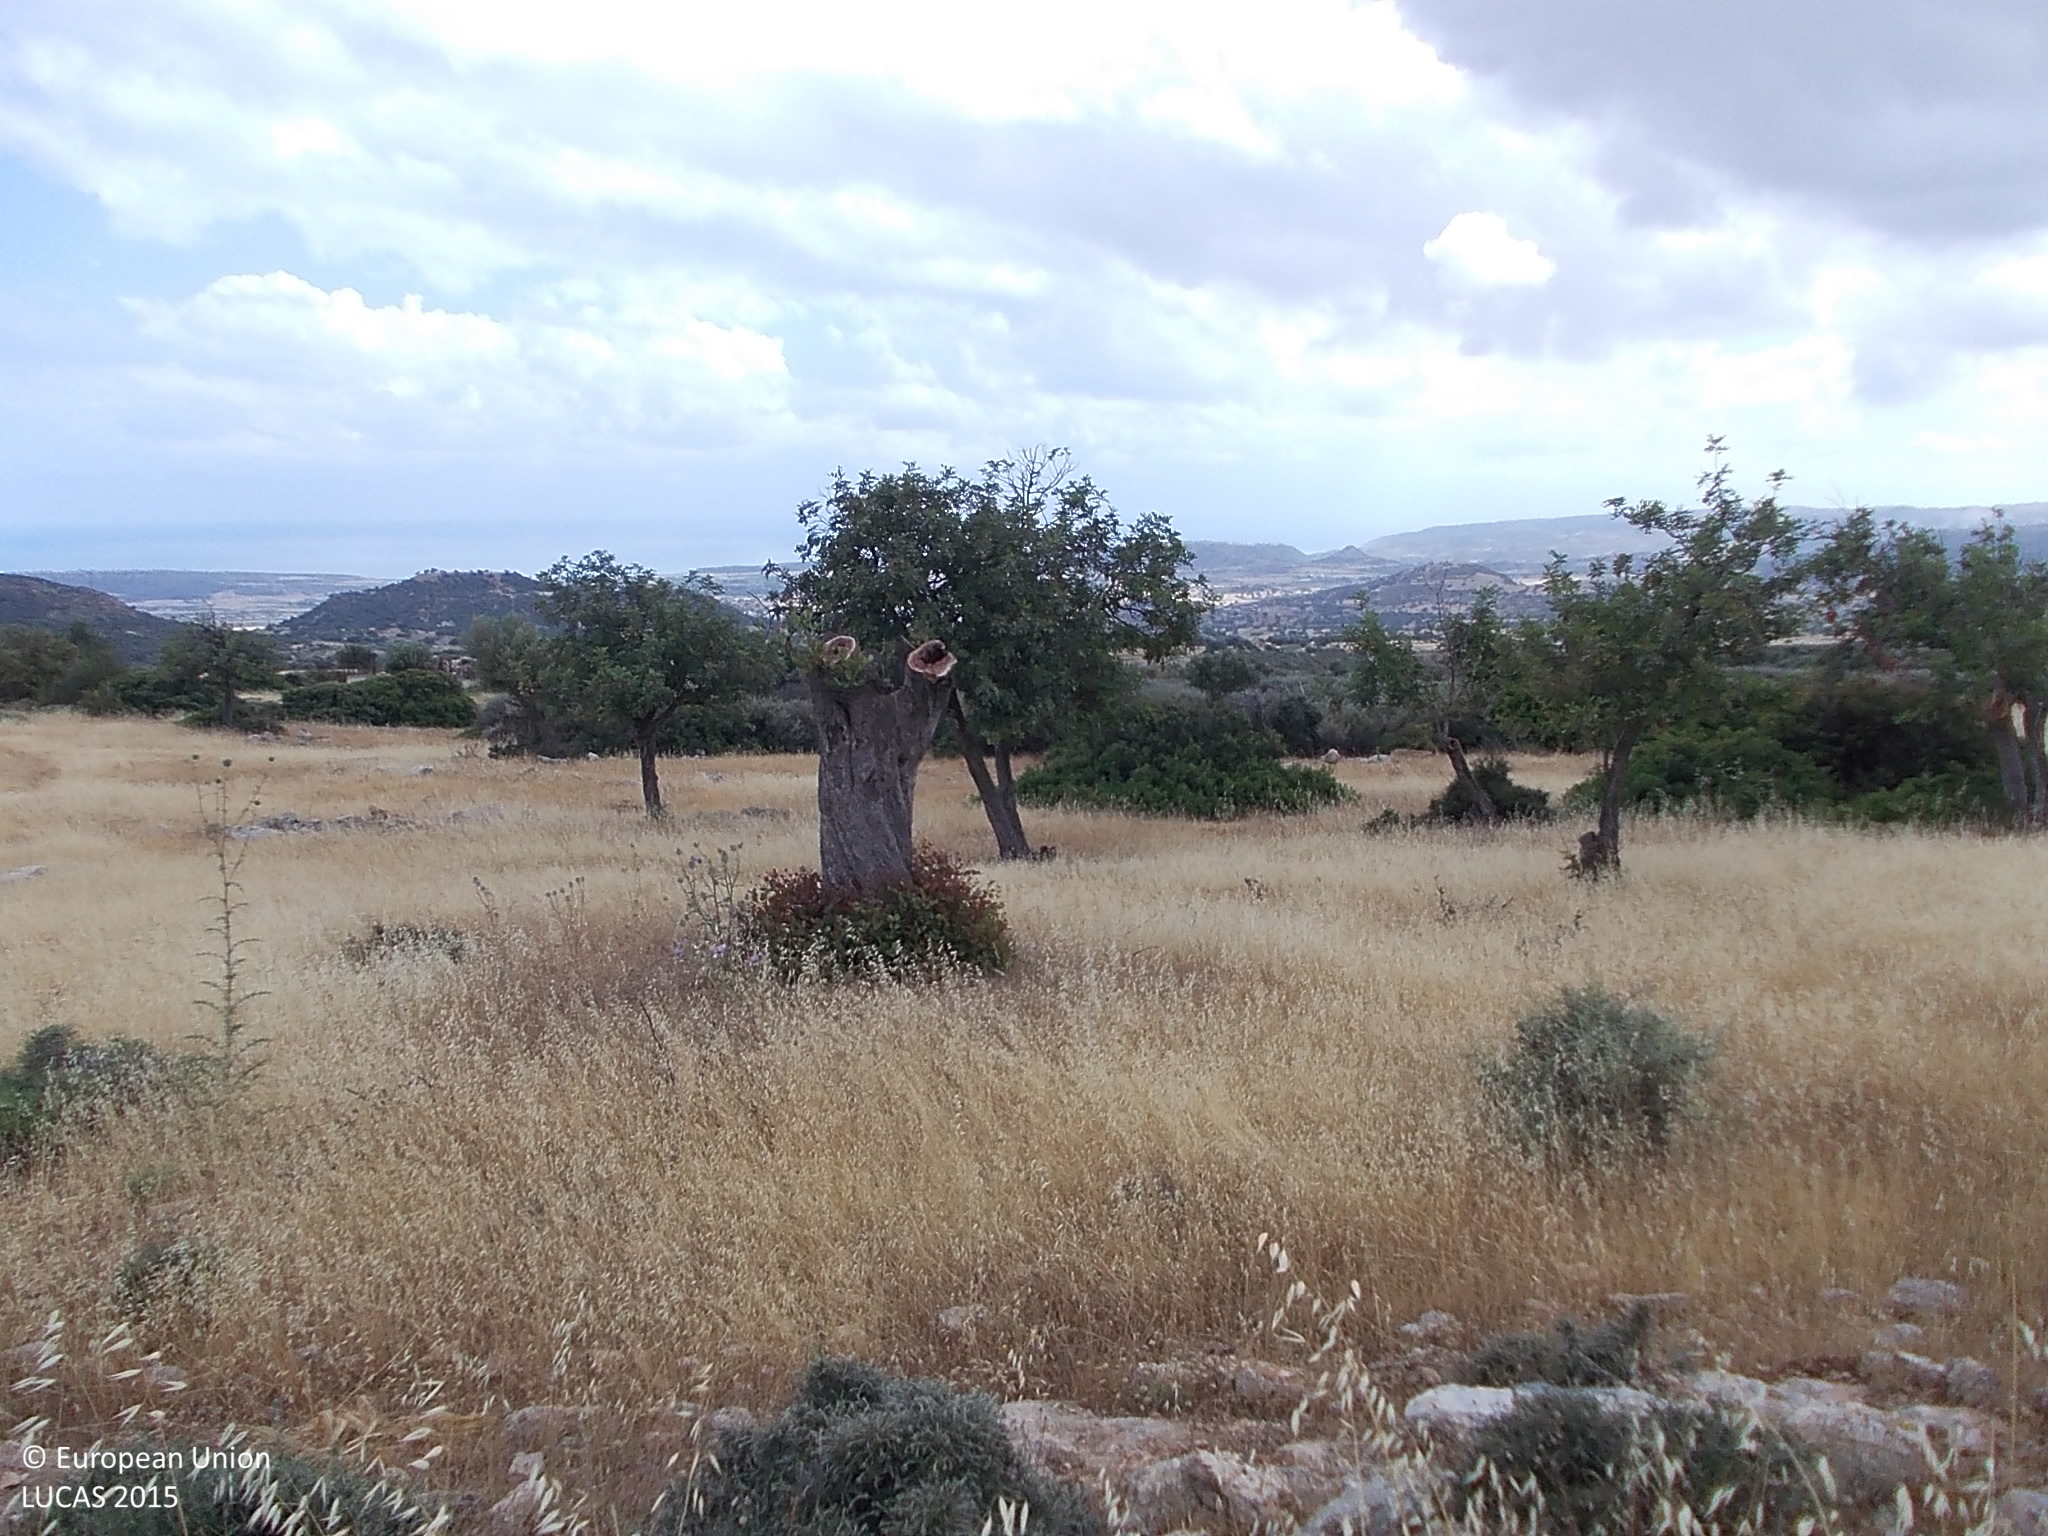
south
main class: Grassland
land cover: Grassland with sparse tree/shrub cover
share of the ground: > 75 %
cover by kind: herbaceous plants 85 %, coniferous forest trees 5 %, shrubs 5 %, consolidated bare surface 5 %
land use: Semi-natural and natural areas not in use
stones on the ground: 10 - 25 %
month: May
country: CY
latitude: 34.7211
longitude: 32.7707
